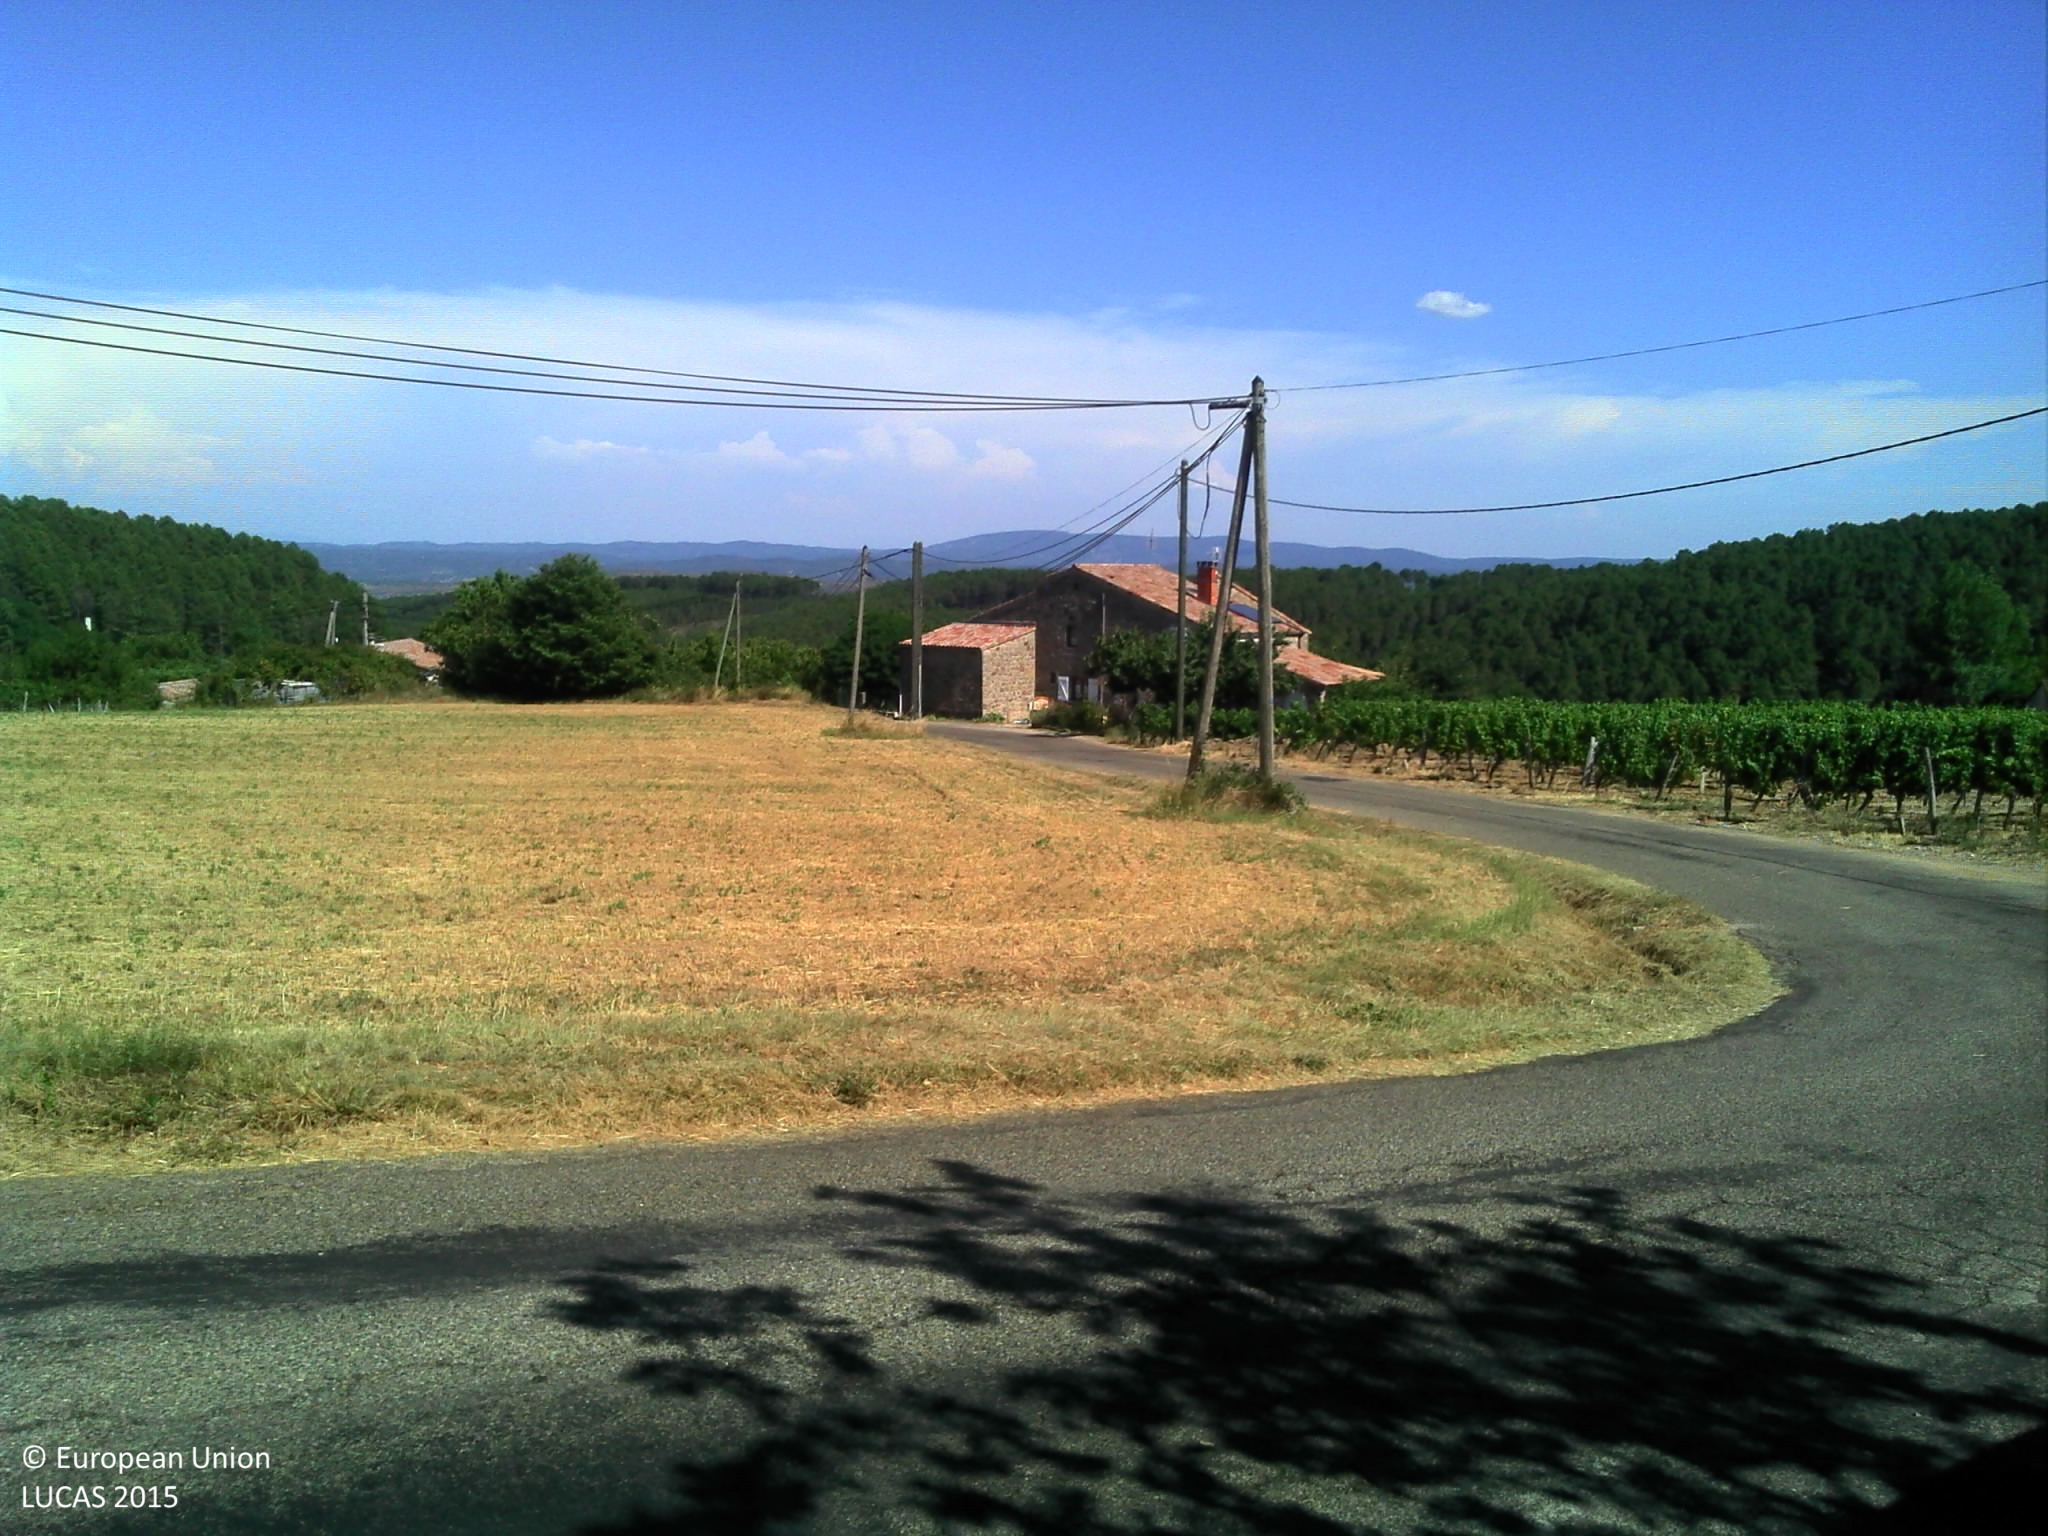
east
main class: Grassland
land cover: Grassland with sparse tree/shrub cover
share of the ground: > 75 %
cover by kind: herbaceous plants 95 %, broadleaved forest trees 5 %
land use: Residential
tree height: < 5 m
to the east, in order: Grassland with sparse tree/shrub cover; Shrubland with sparse tree cover; Grass margins; Paved roads, cycling and walking lanes; Grass margins; Mixed cereals for fodder; Grass margins; Dry stone walls; Tracks; Vineyards; Fences; Temporary grasslands; Lines of trees; Artificial constructions in urban areas; Grassland without tree/shrub cover
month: July
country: FR
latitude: 44.5349
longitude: 4.2552
